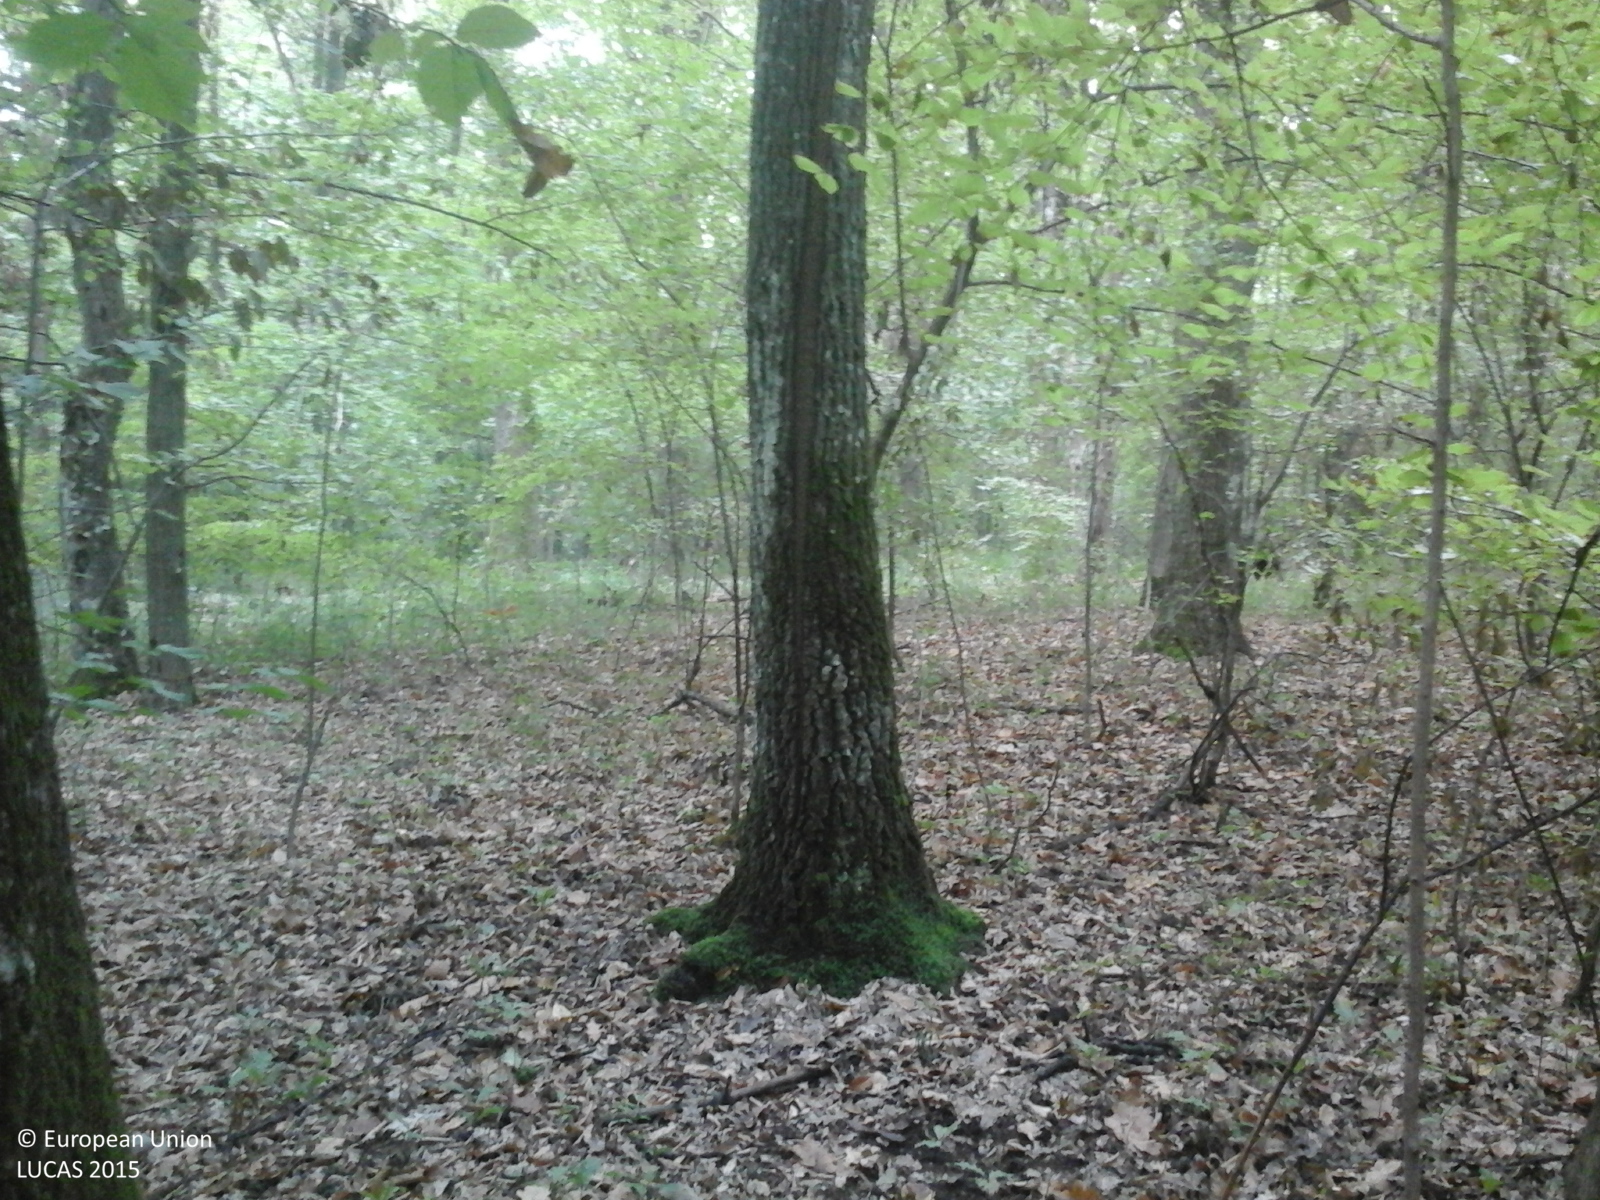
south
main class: Woodland
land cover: Broadleaved woodland
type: beech forest
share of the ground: > 75 %
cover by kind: broadleaved forest trees 100 %
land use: Forestry
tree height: > 5 m
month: September
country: RO
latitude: 44.9426
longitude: 23.2198
